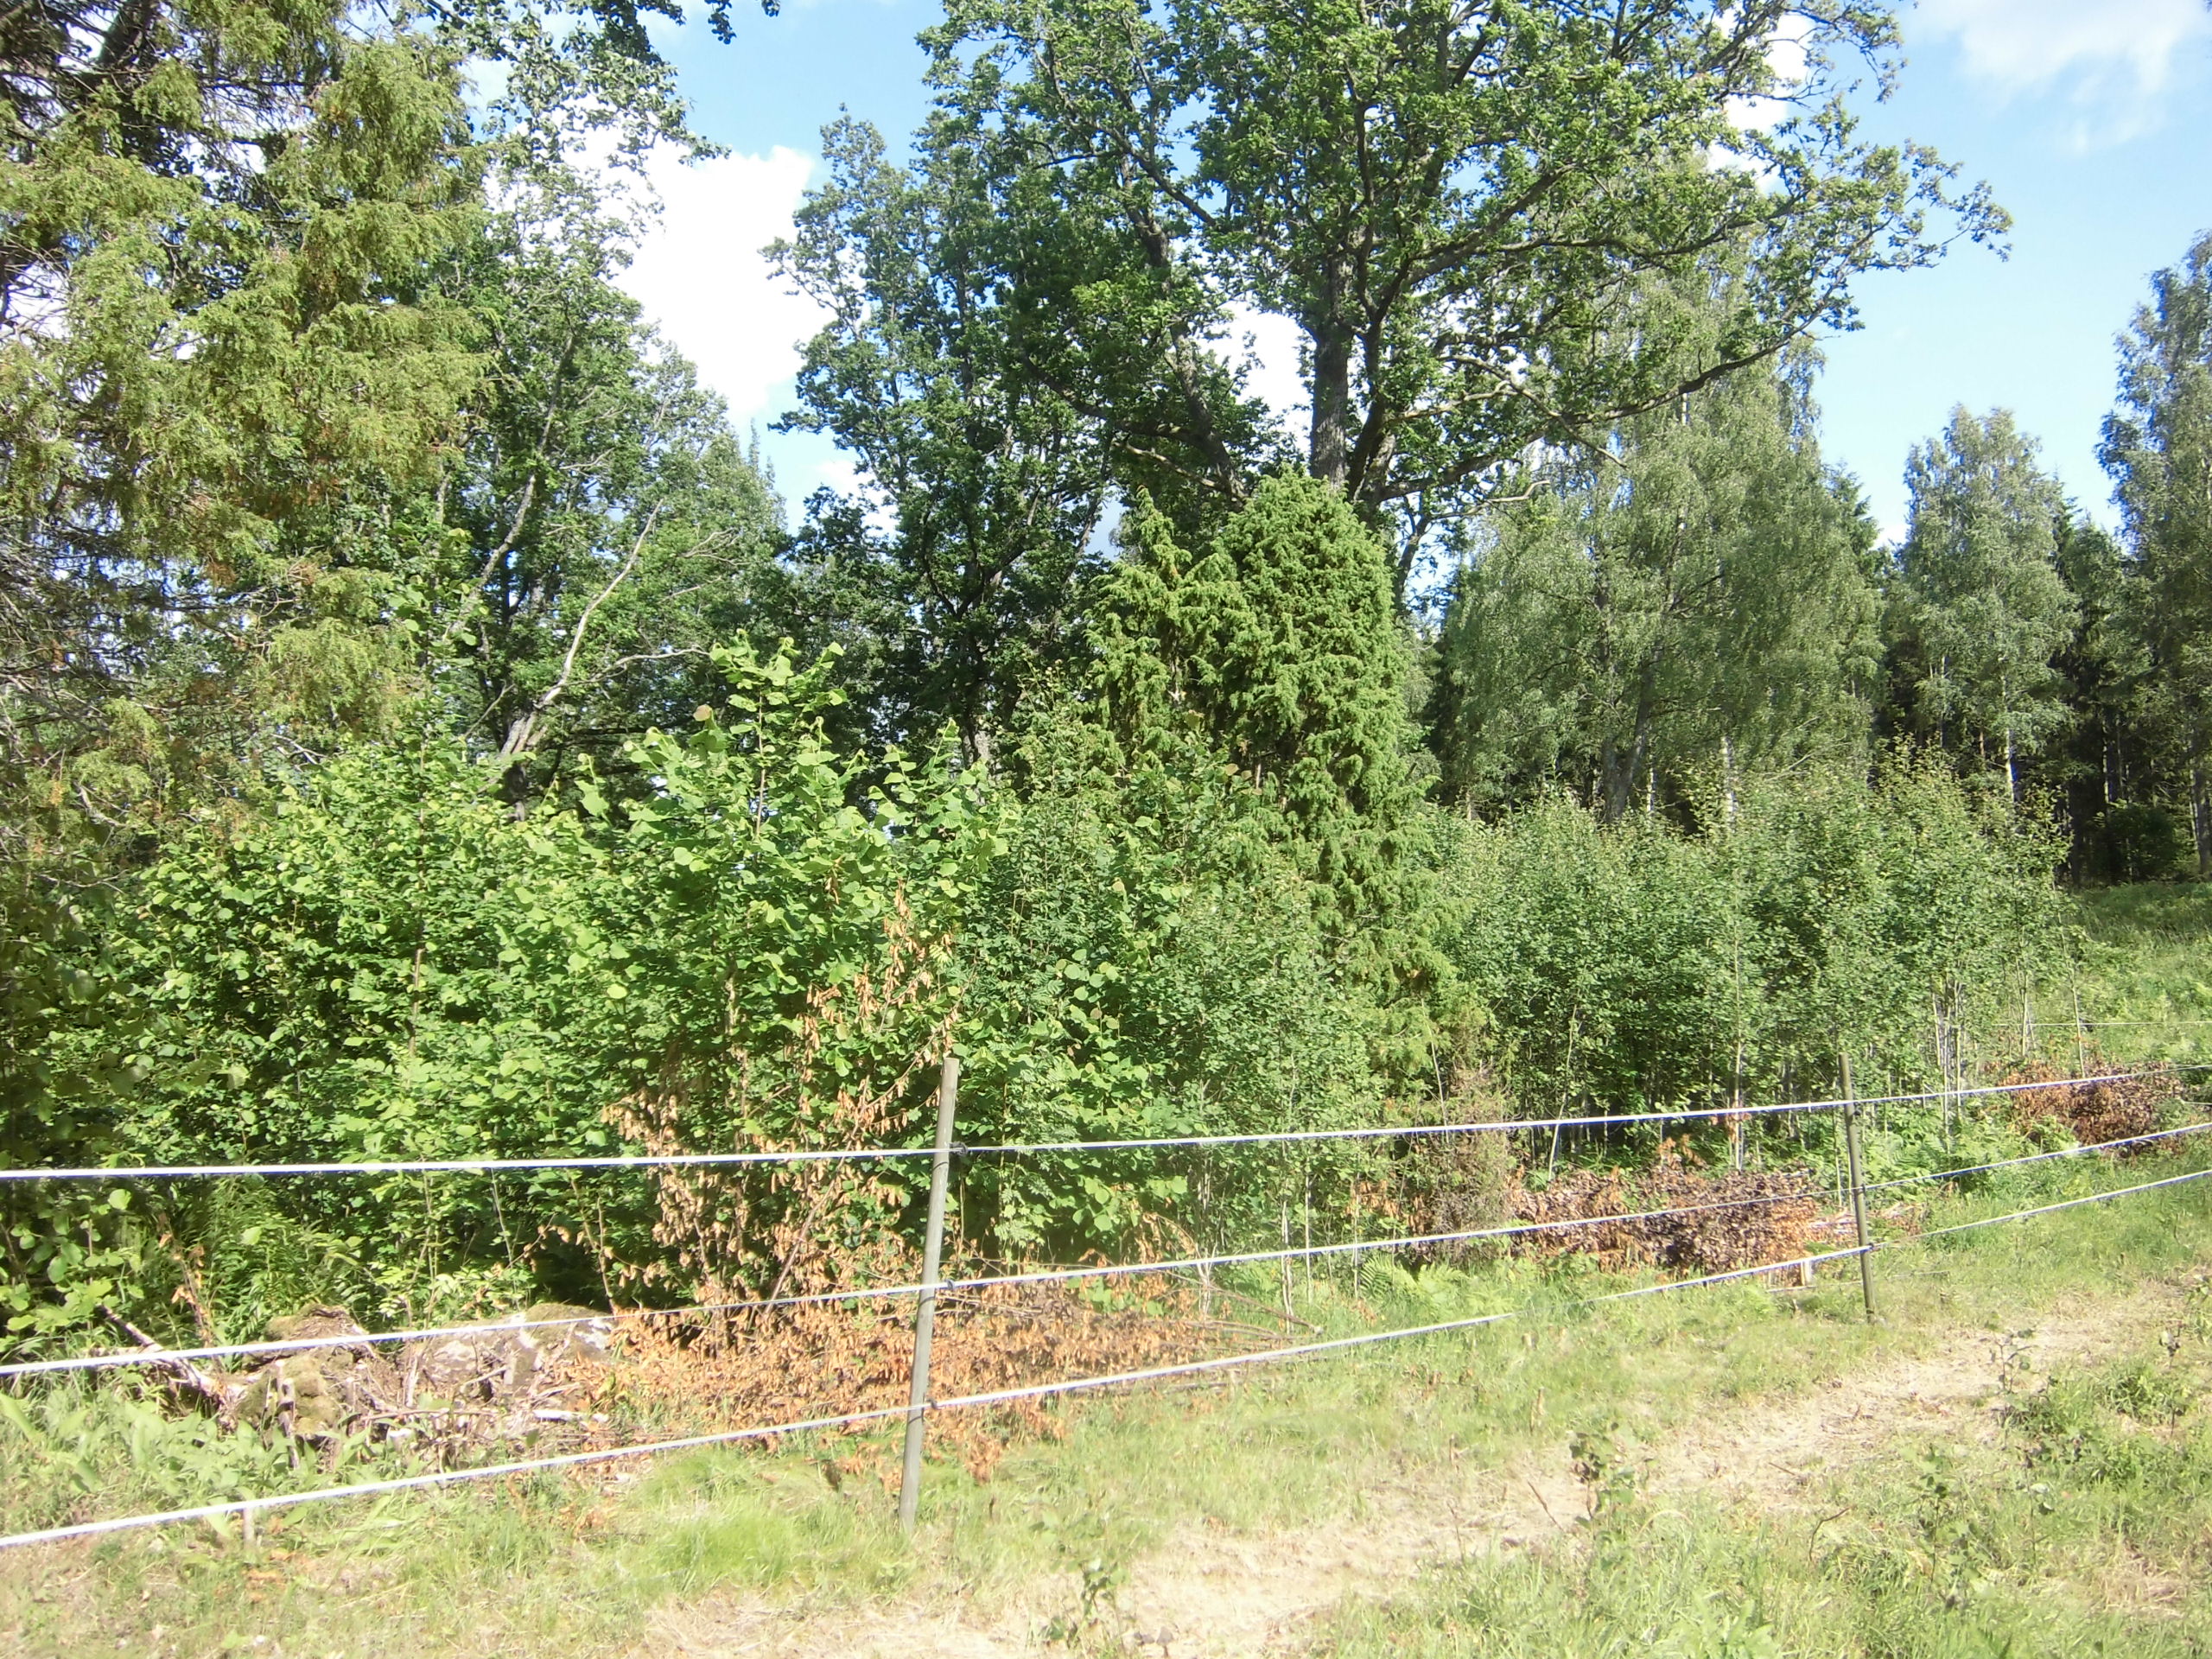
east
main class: Grassland
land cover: Grassland with sparse tree/shrub cover
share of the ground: > 75 %
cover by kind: herbaceous plants 95 %, broadleaved forest trees 5 %
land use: Agriculture (excluding fallow land and kitchen gardens)
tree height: < 5 m
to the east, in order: Grassland with sparse tree/shrub cover; Fences; Broadleaved woodland; Fences; Grassland with sparse tree/shrub cover; Broadleaved woodland; Fences; Grassland without tree/shrub cover; Fences; Grassland without tree/shrub cover; Fences; Broadleaved woodland
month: July
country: SE
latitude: 57.2119
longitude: 15.3451
